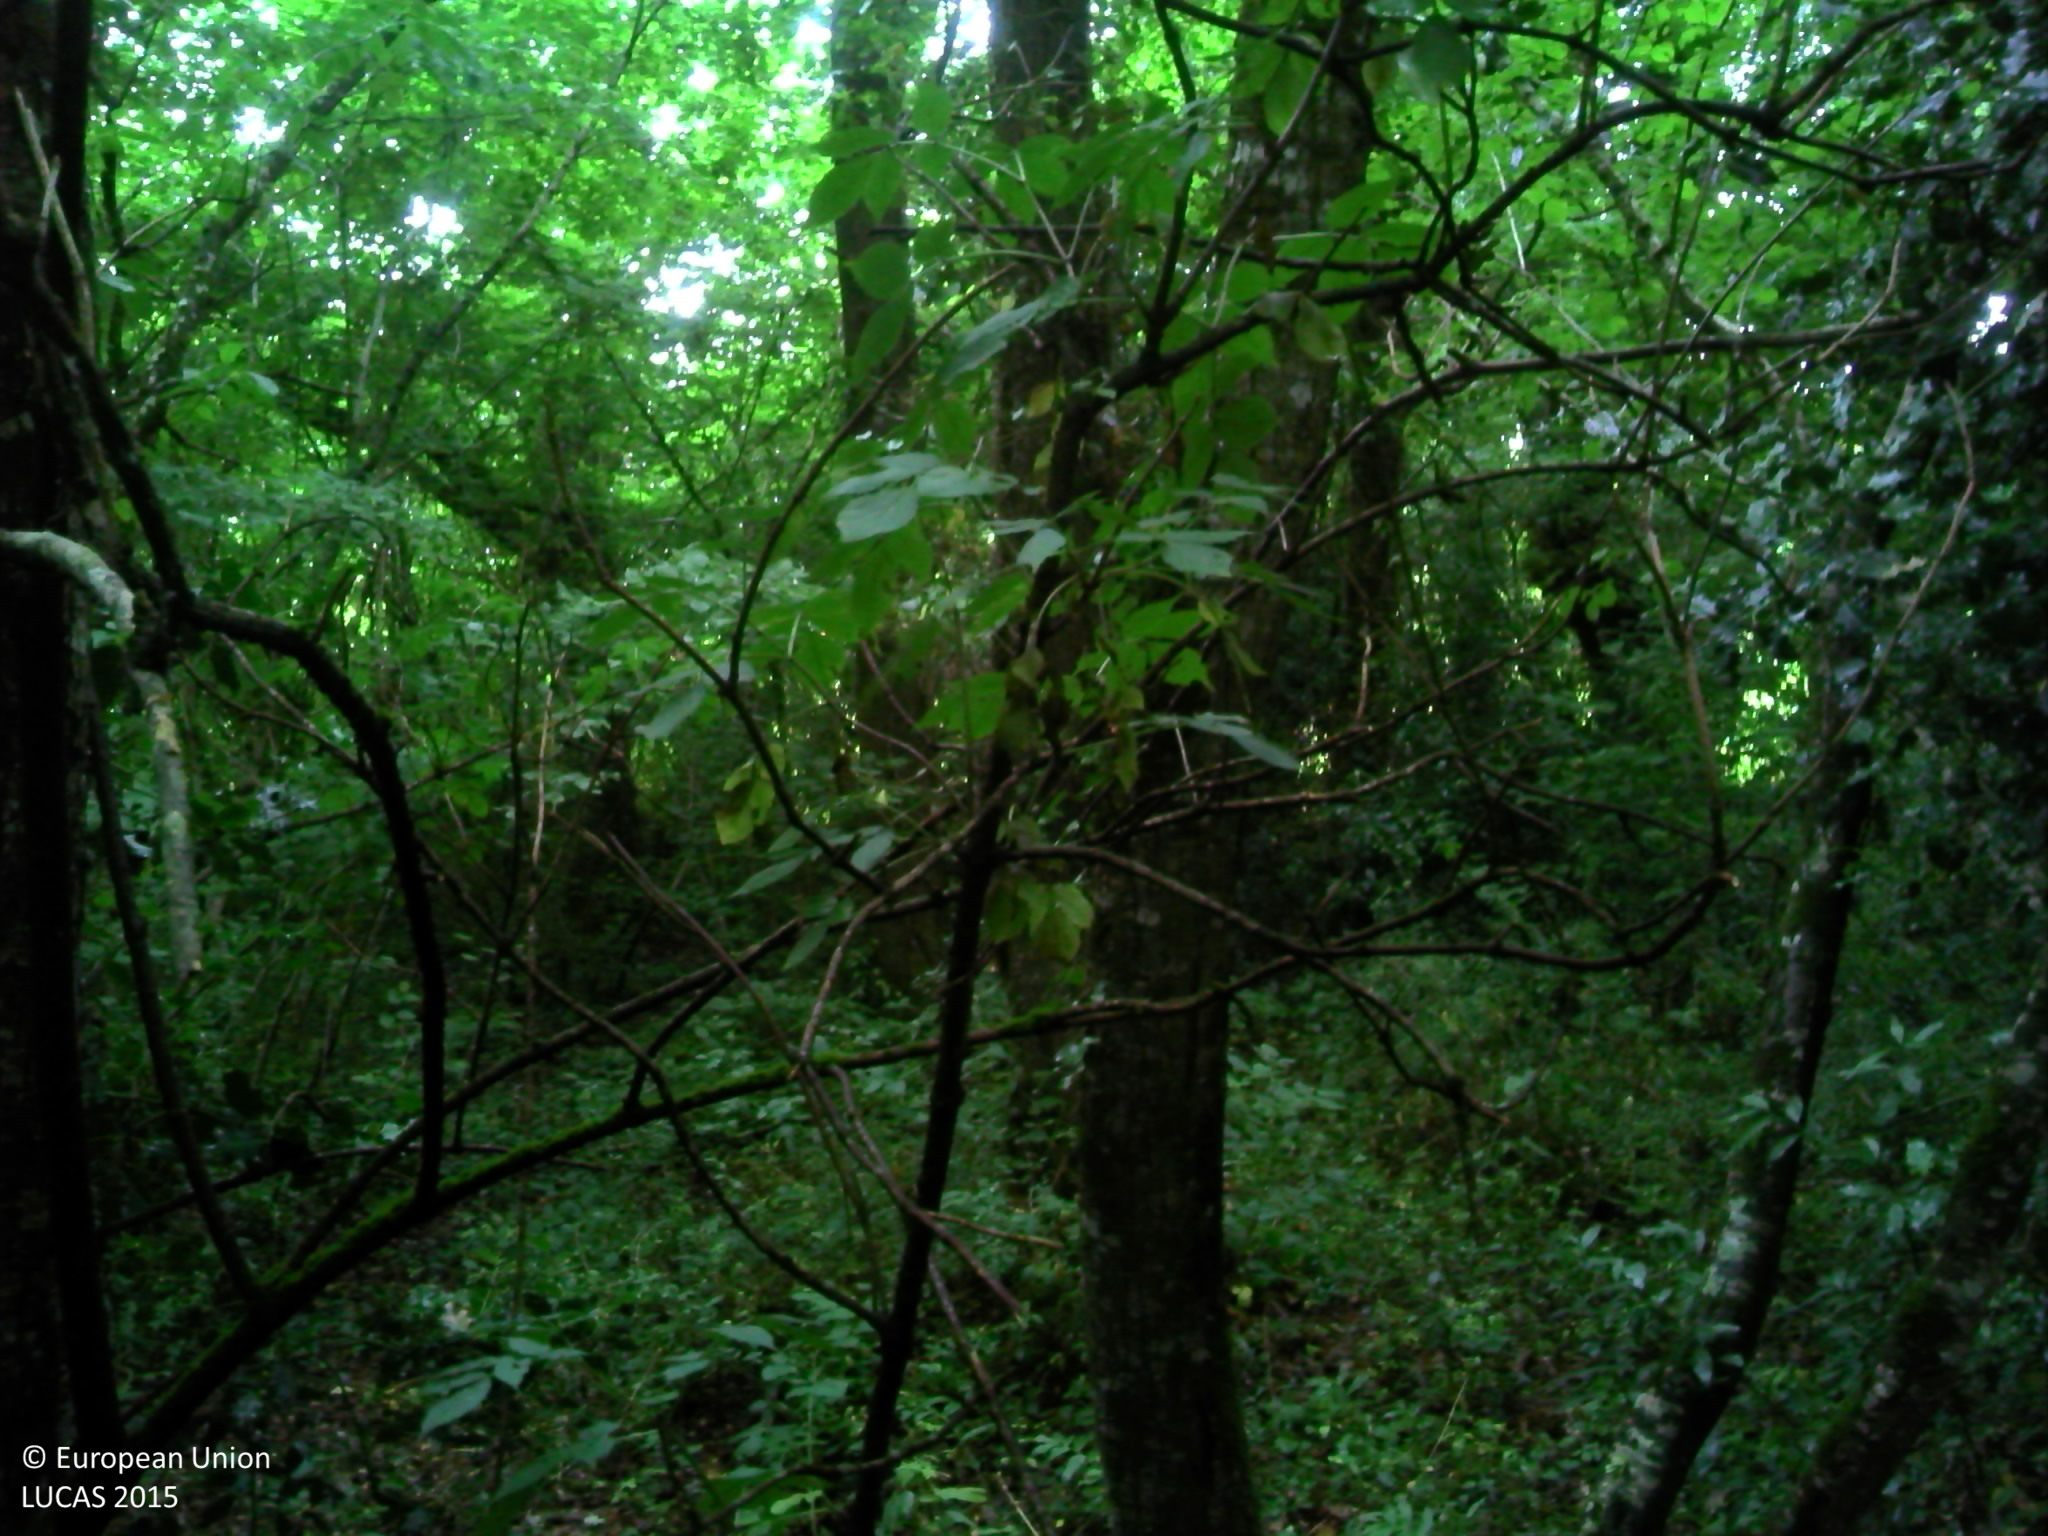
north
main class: Woodland
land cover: Broadleaved woodland
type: non-riverine alder, birch or aspen forest
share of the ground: > 75 %
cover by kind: broadleaved forest trees 95 %, herbaceous plants 5 %
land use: Semi-natural and natural areas not in use
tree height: > 5 m
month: July
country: FR
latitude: 47.1782
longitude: -1.8822
